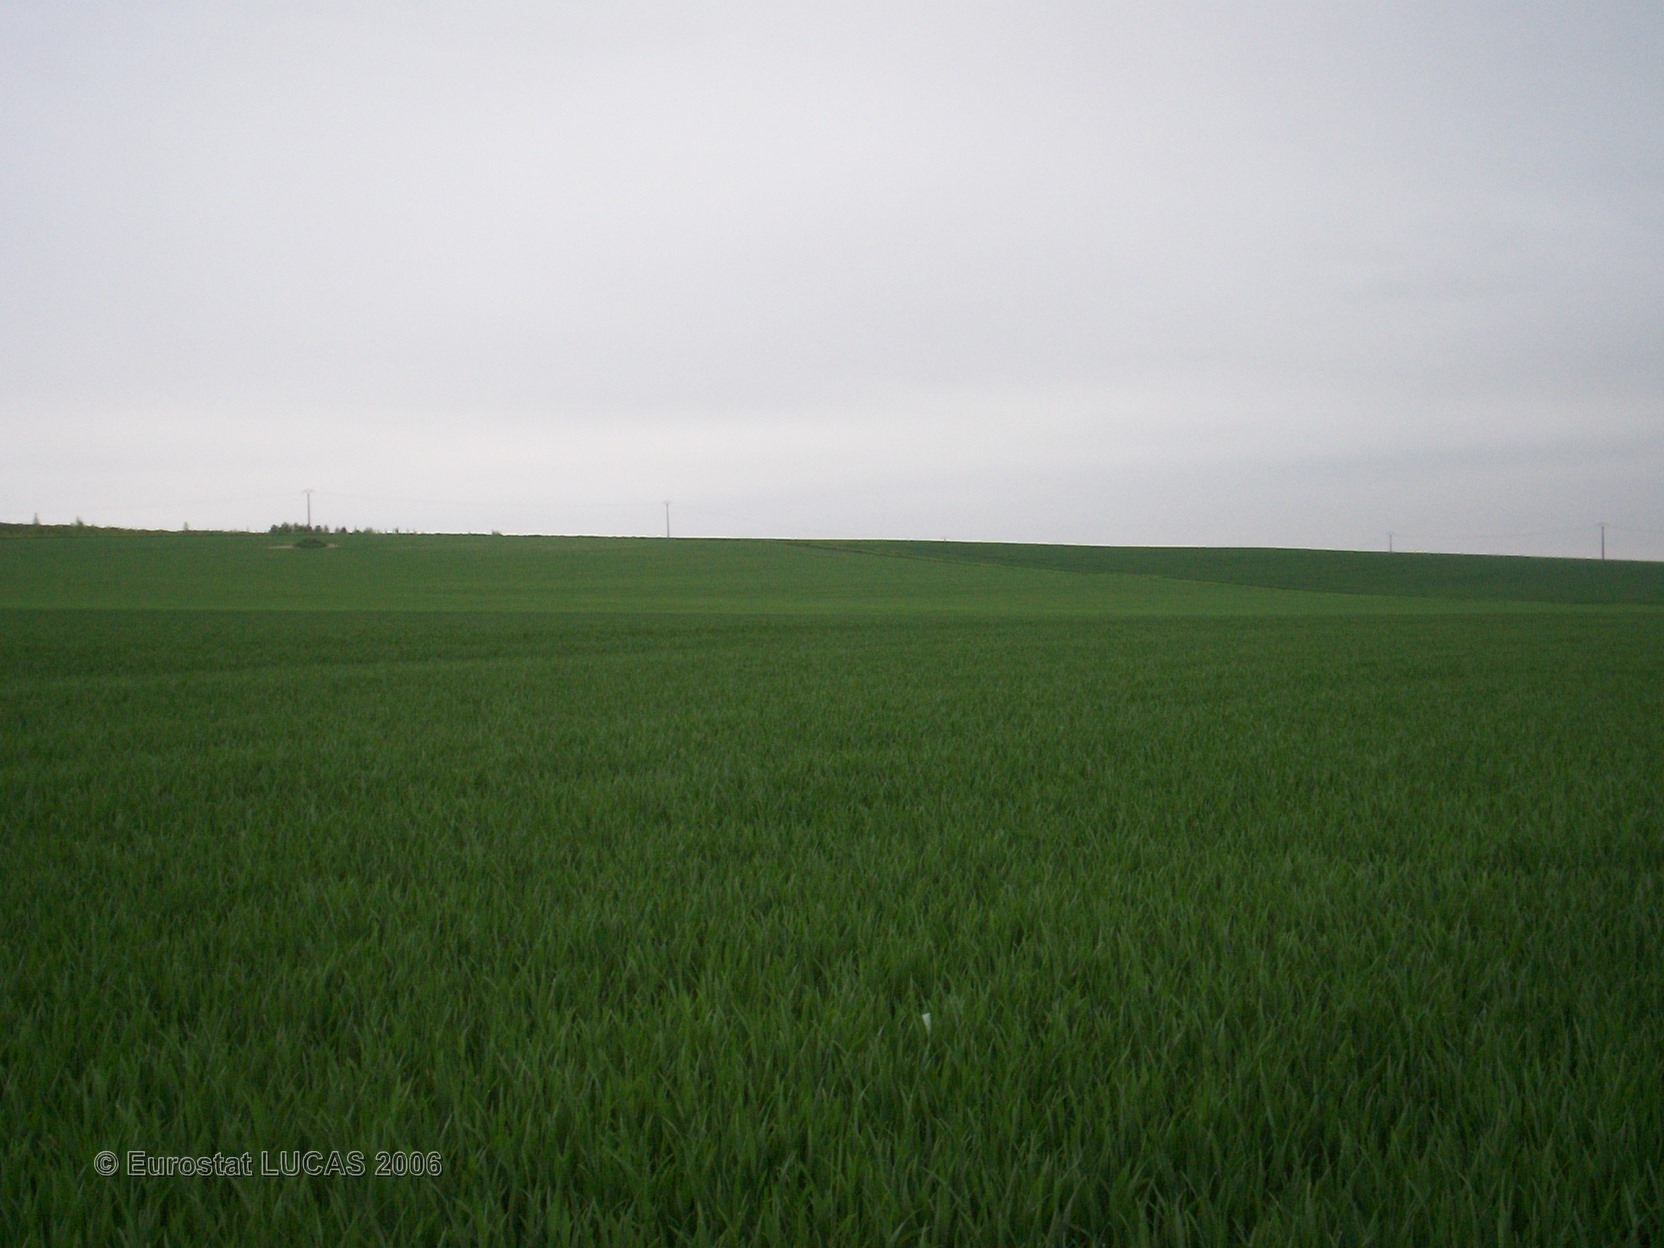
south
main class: Cropland
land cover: Common wheat
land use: Agriculture (excluding fallow land and kitchen gardens)
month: May
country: FR
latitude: 49.5212
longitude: 4.3459
